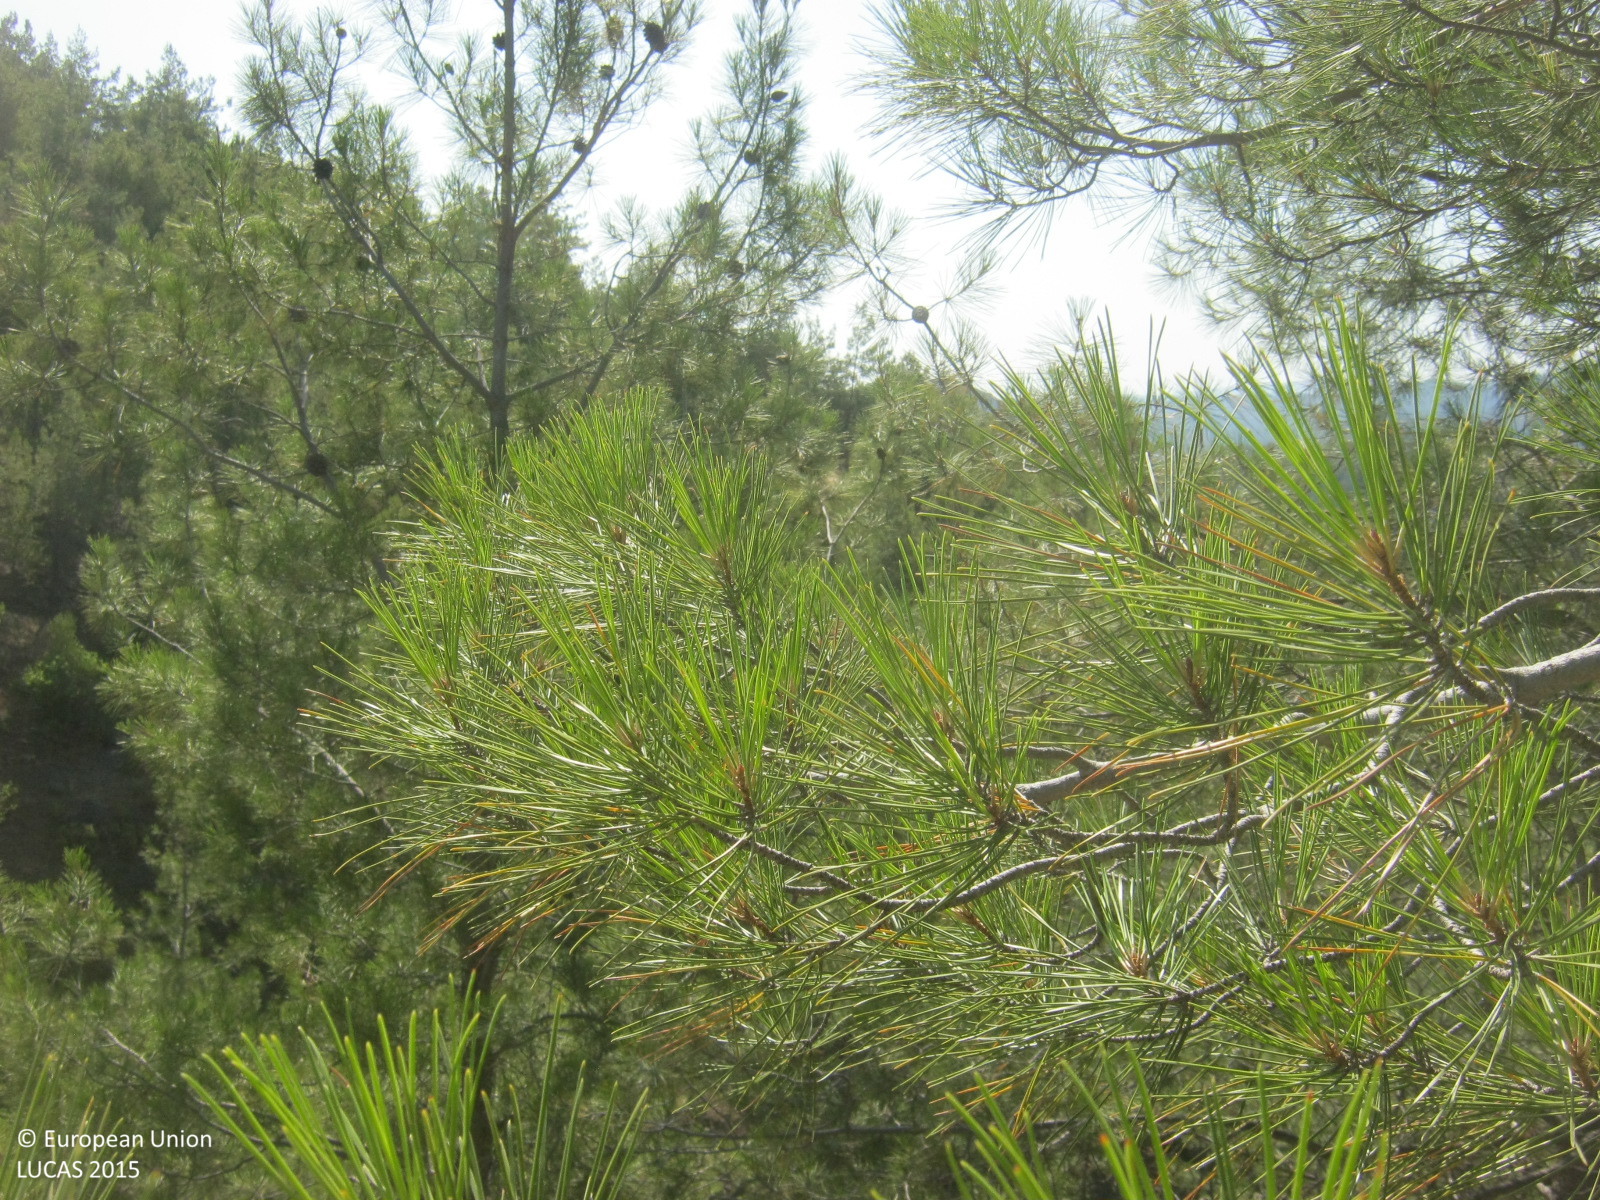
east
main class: Woodland
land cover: Pine dominated coniferous woodland
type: coniferous forest of the mediterranean region
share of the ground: 50 - 75 %
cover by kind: coniferous forest trees 60 %, shrubs 15 %, herbaceous plants 10 %, unconsolidated bare surface 10 %, broadleaved forest trees 5 %
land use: Forestry
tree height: > 5 m
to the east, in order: Pine dominated coniferous woodland; Rivers and streams; Pine dominated coniferous woodland; Pine dominated mixed woodland
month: June
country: CY
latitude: 35.0410
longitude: 32.9871
